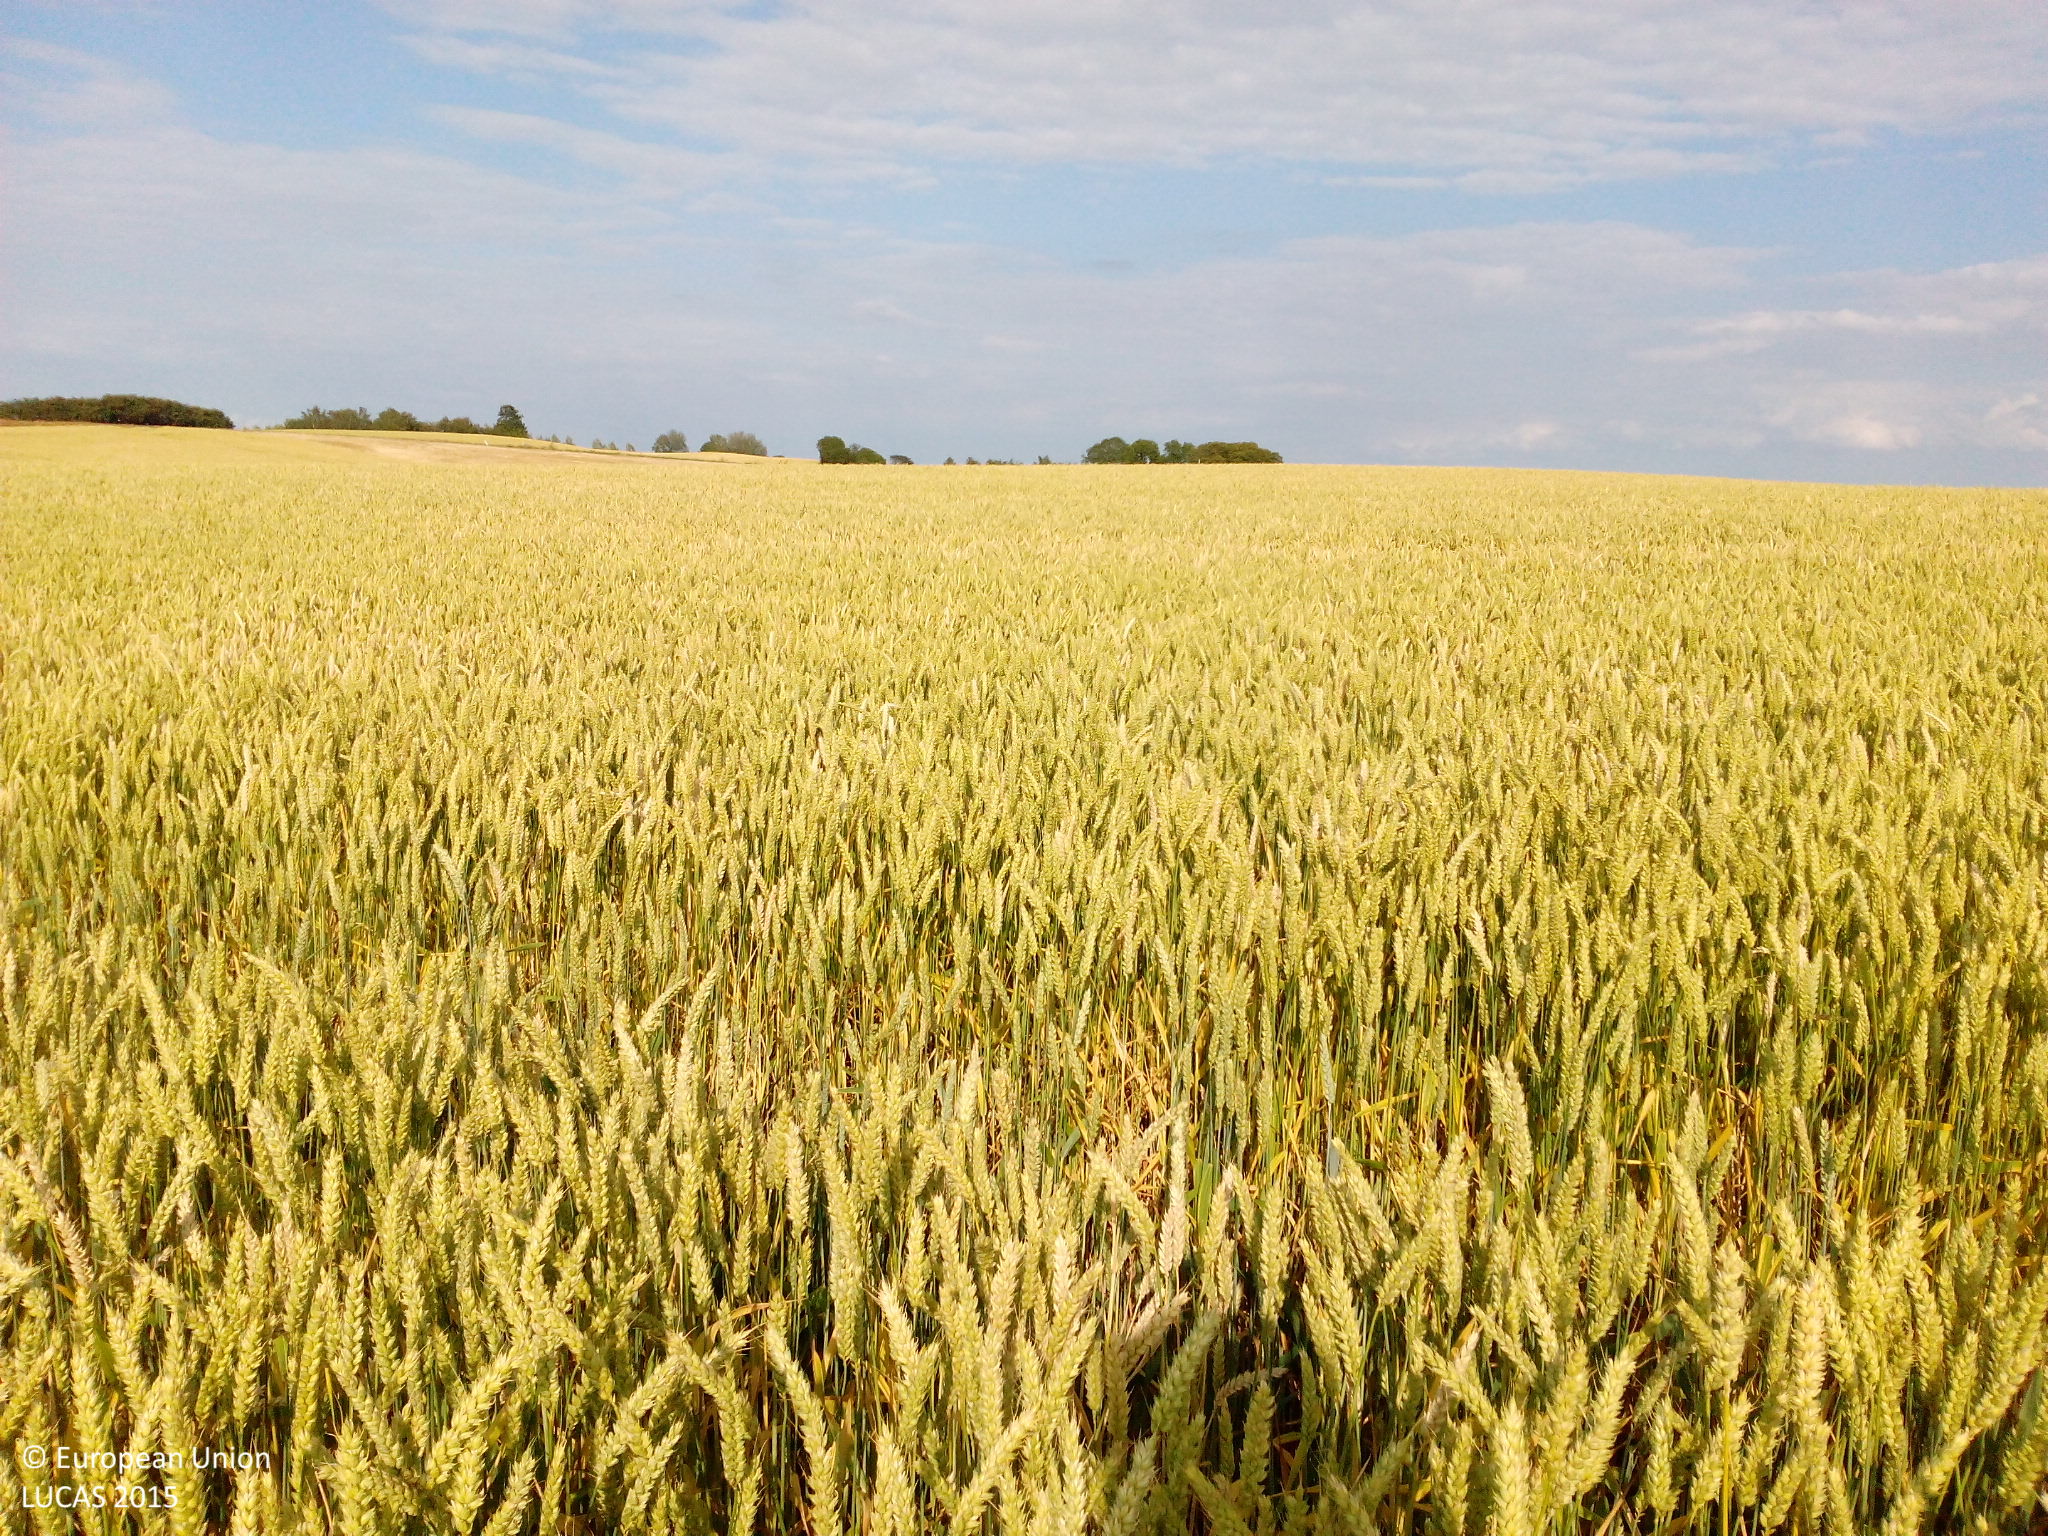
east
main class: Cropland
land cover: Common wheat
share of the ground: > 75 %
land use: Agriculture (excluding fallow land and kitchen gardens)
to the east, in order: Common wheat; Barley
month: July
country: DK
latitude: 55.7423
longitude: 11.8938
